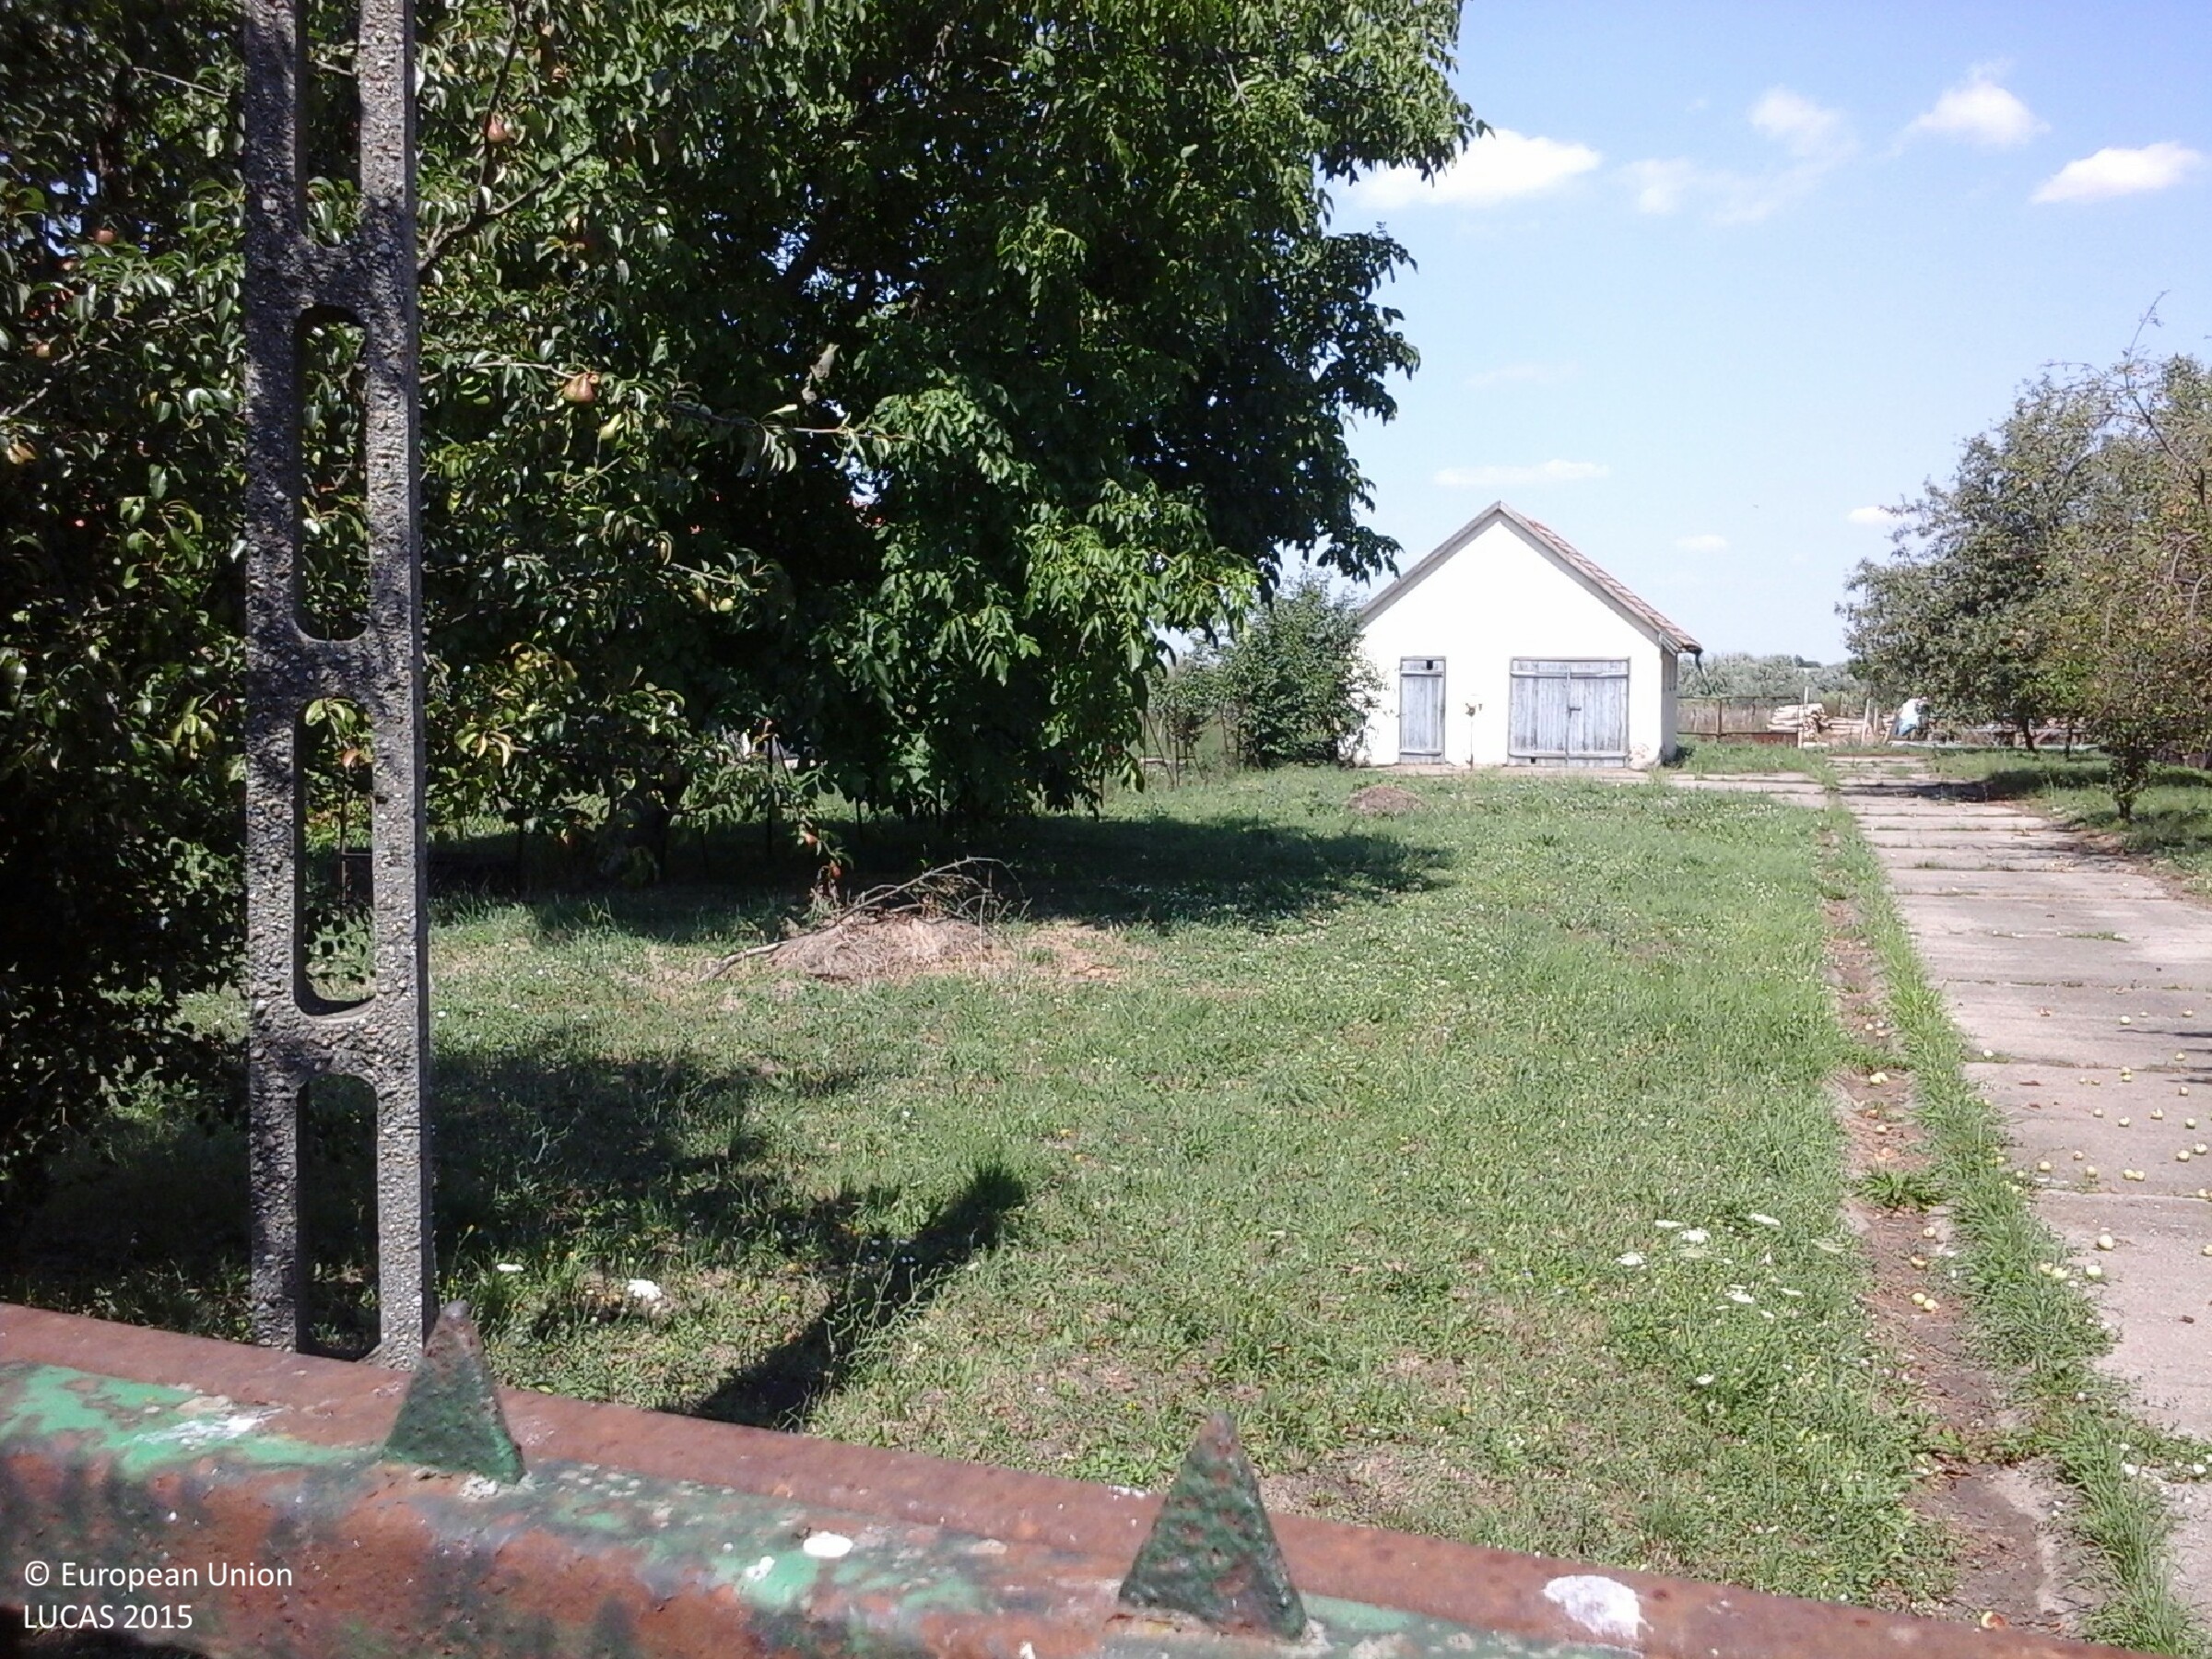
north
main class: Grassland
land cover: Grassland without tree/shrub cover
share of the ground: > 75 %
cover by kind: herbaceous plants 100 %
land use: Residential
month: July
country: HU
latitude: 47.6522
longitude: 20.6442
